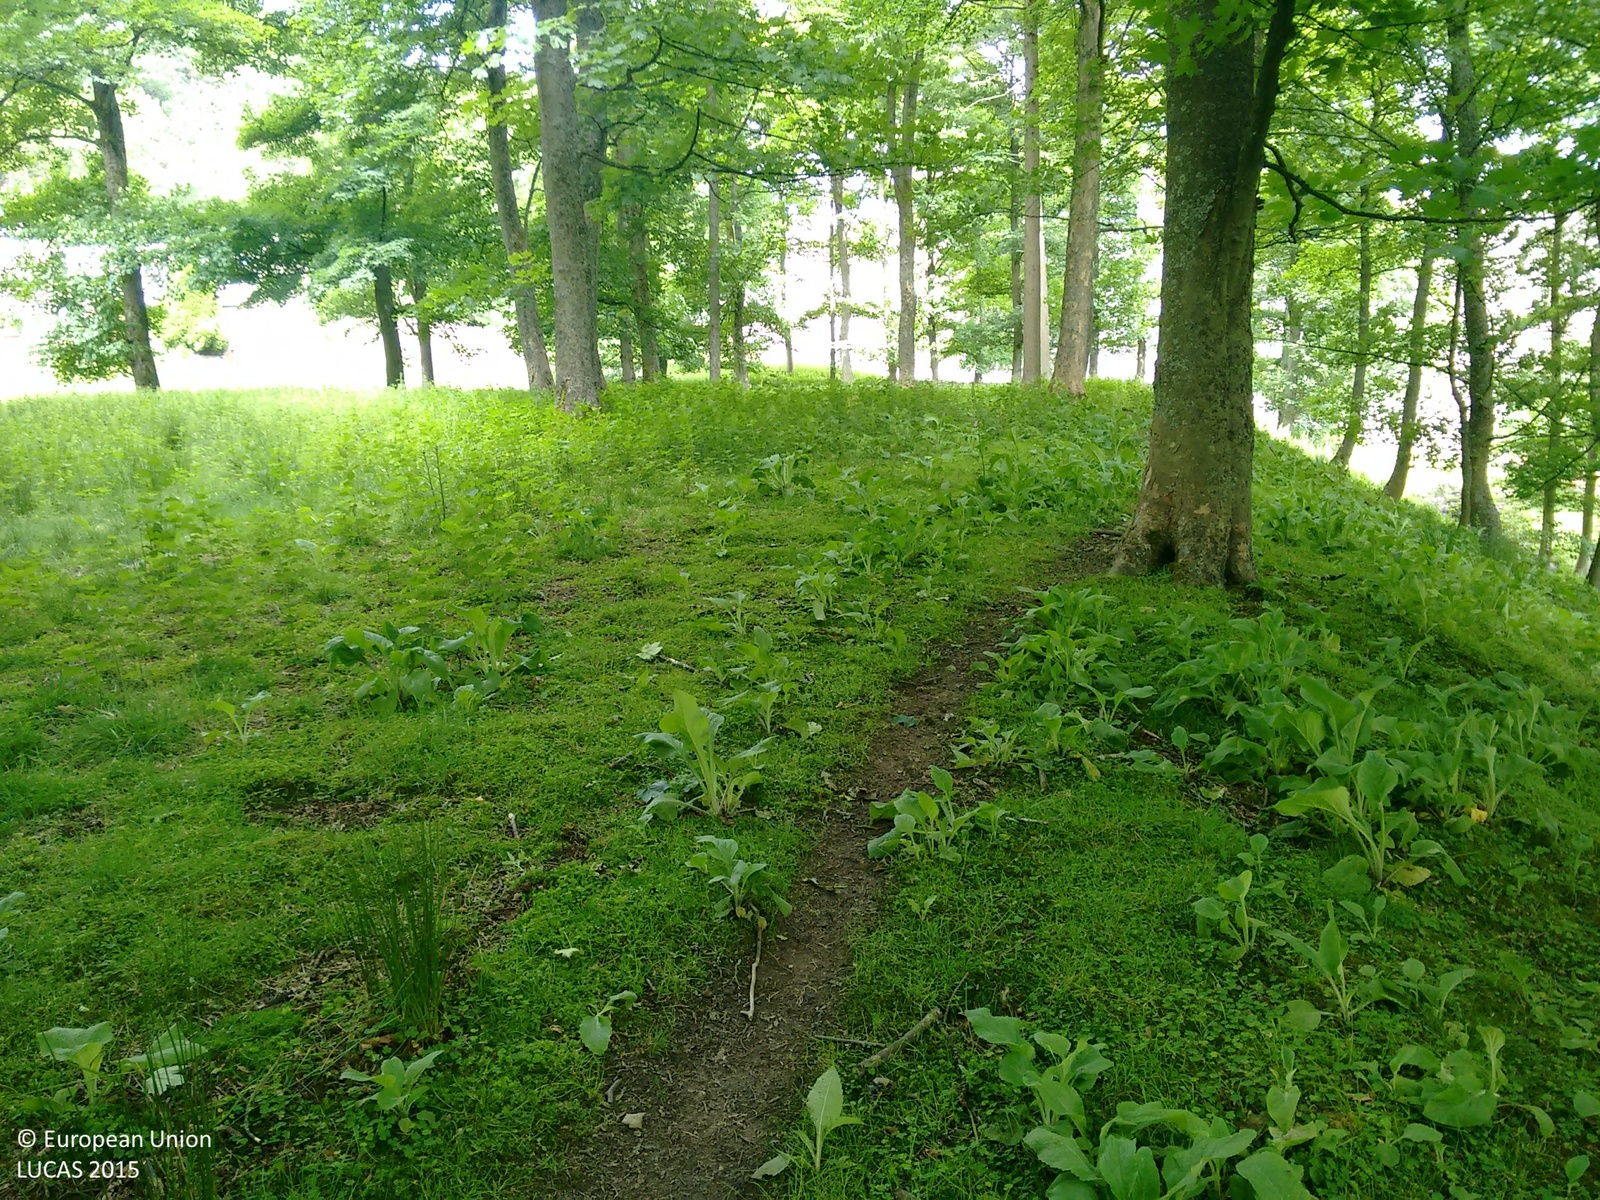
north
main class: Woodland
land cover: Broadleaved woodland
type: mesophytic deciduous forest
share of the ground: > 75 %
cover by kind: broadleaved forest trees 100 %
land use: Amenities, museums, leisure
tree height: > 5 m
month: June
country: GB
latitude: 53.4276
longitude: -1.7474
